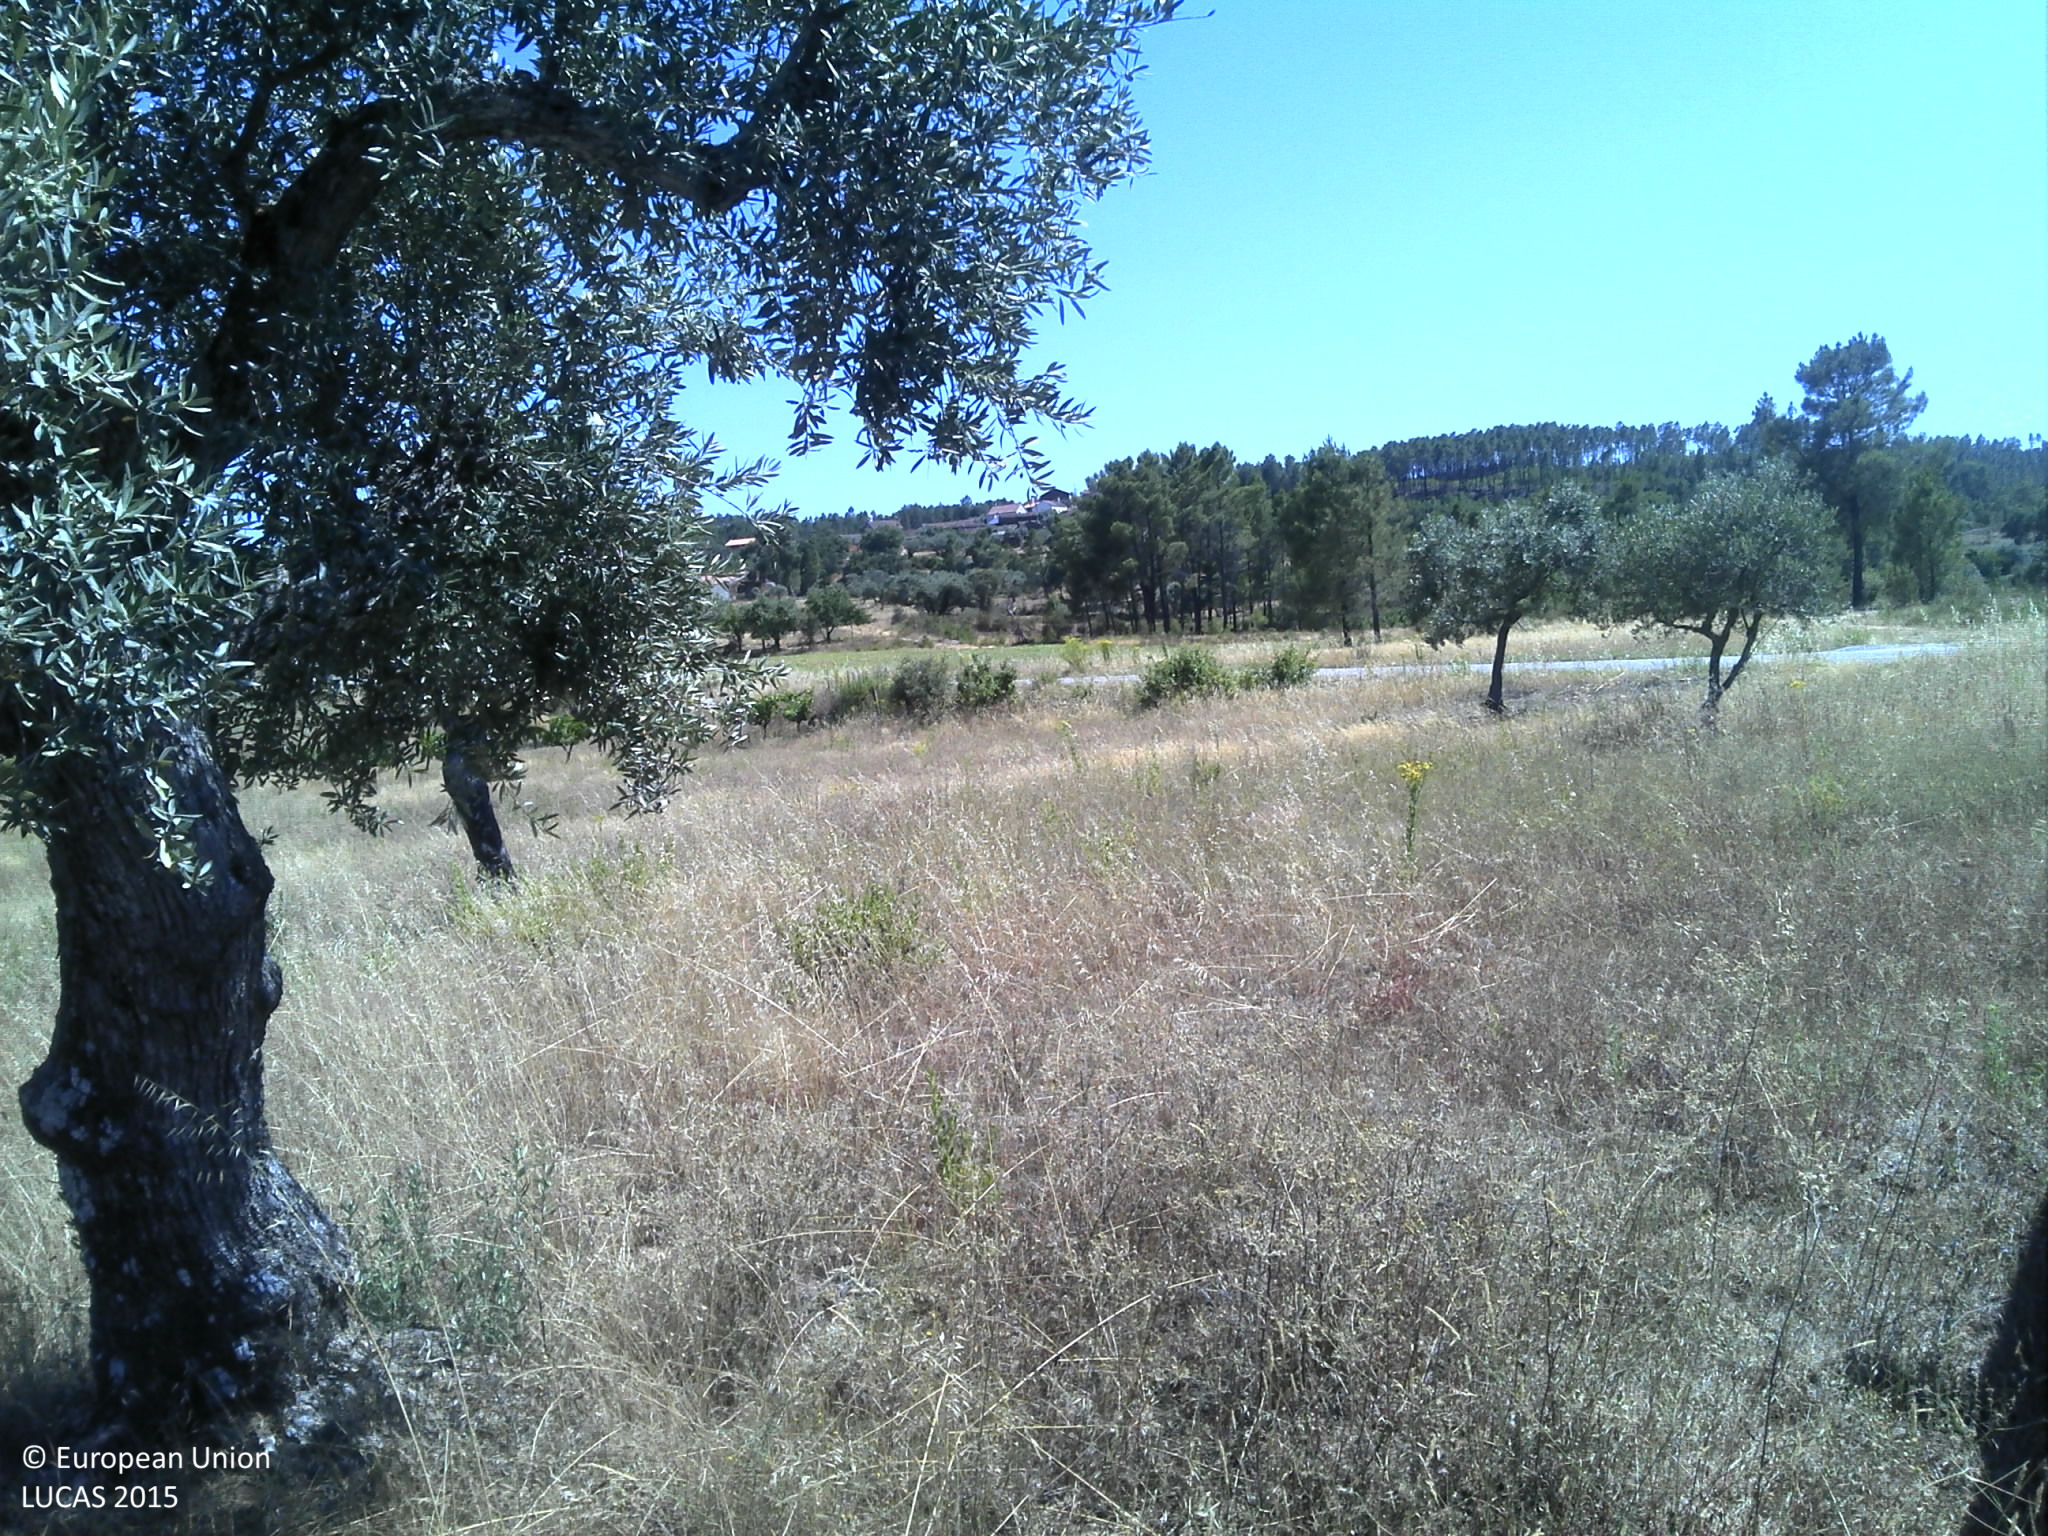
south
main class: Cropland
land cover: Olive groves
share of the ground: 25 - 50 %
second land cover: Grassland without tree/shrub cover
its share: 25 - 50 %
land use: Agriculture (excluding fallow land and kitchen gardens)
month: July
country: PT
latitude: 39.8577
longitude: -7.6248
